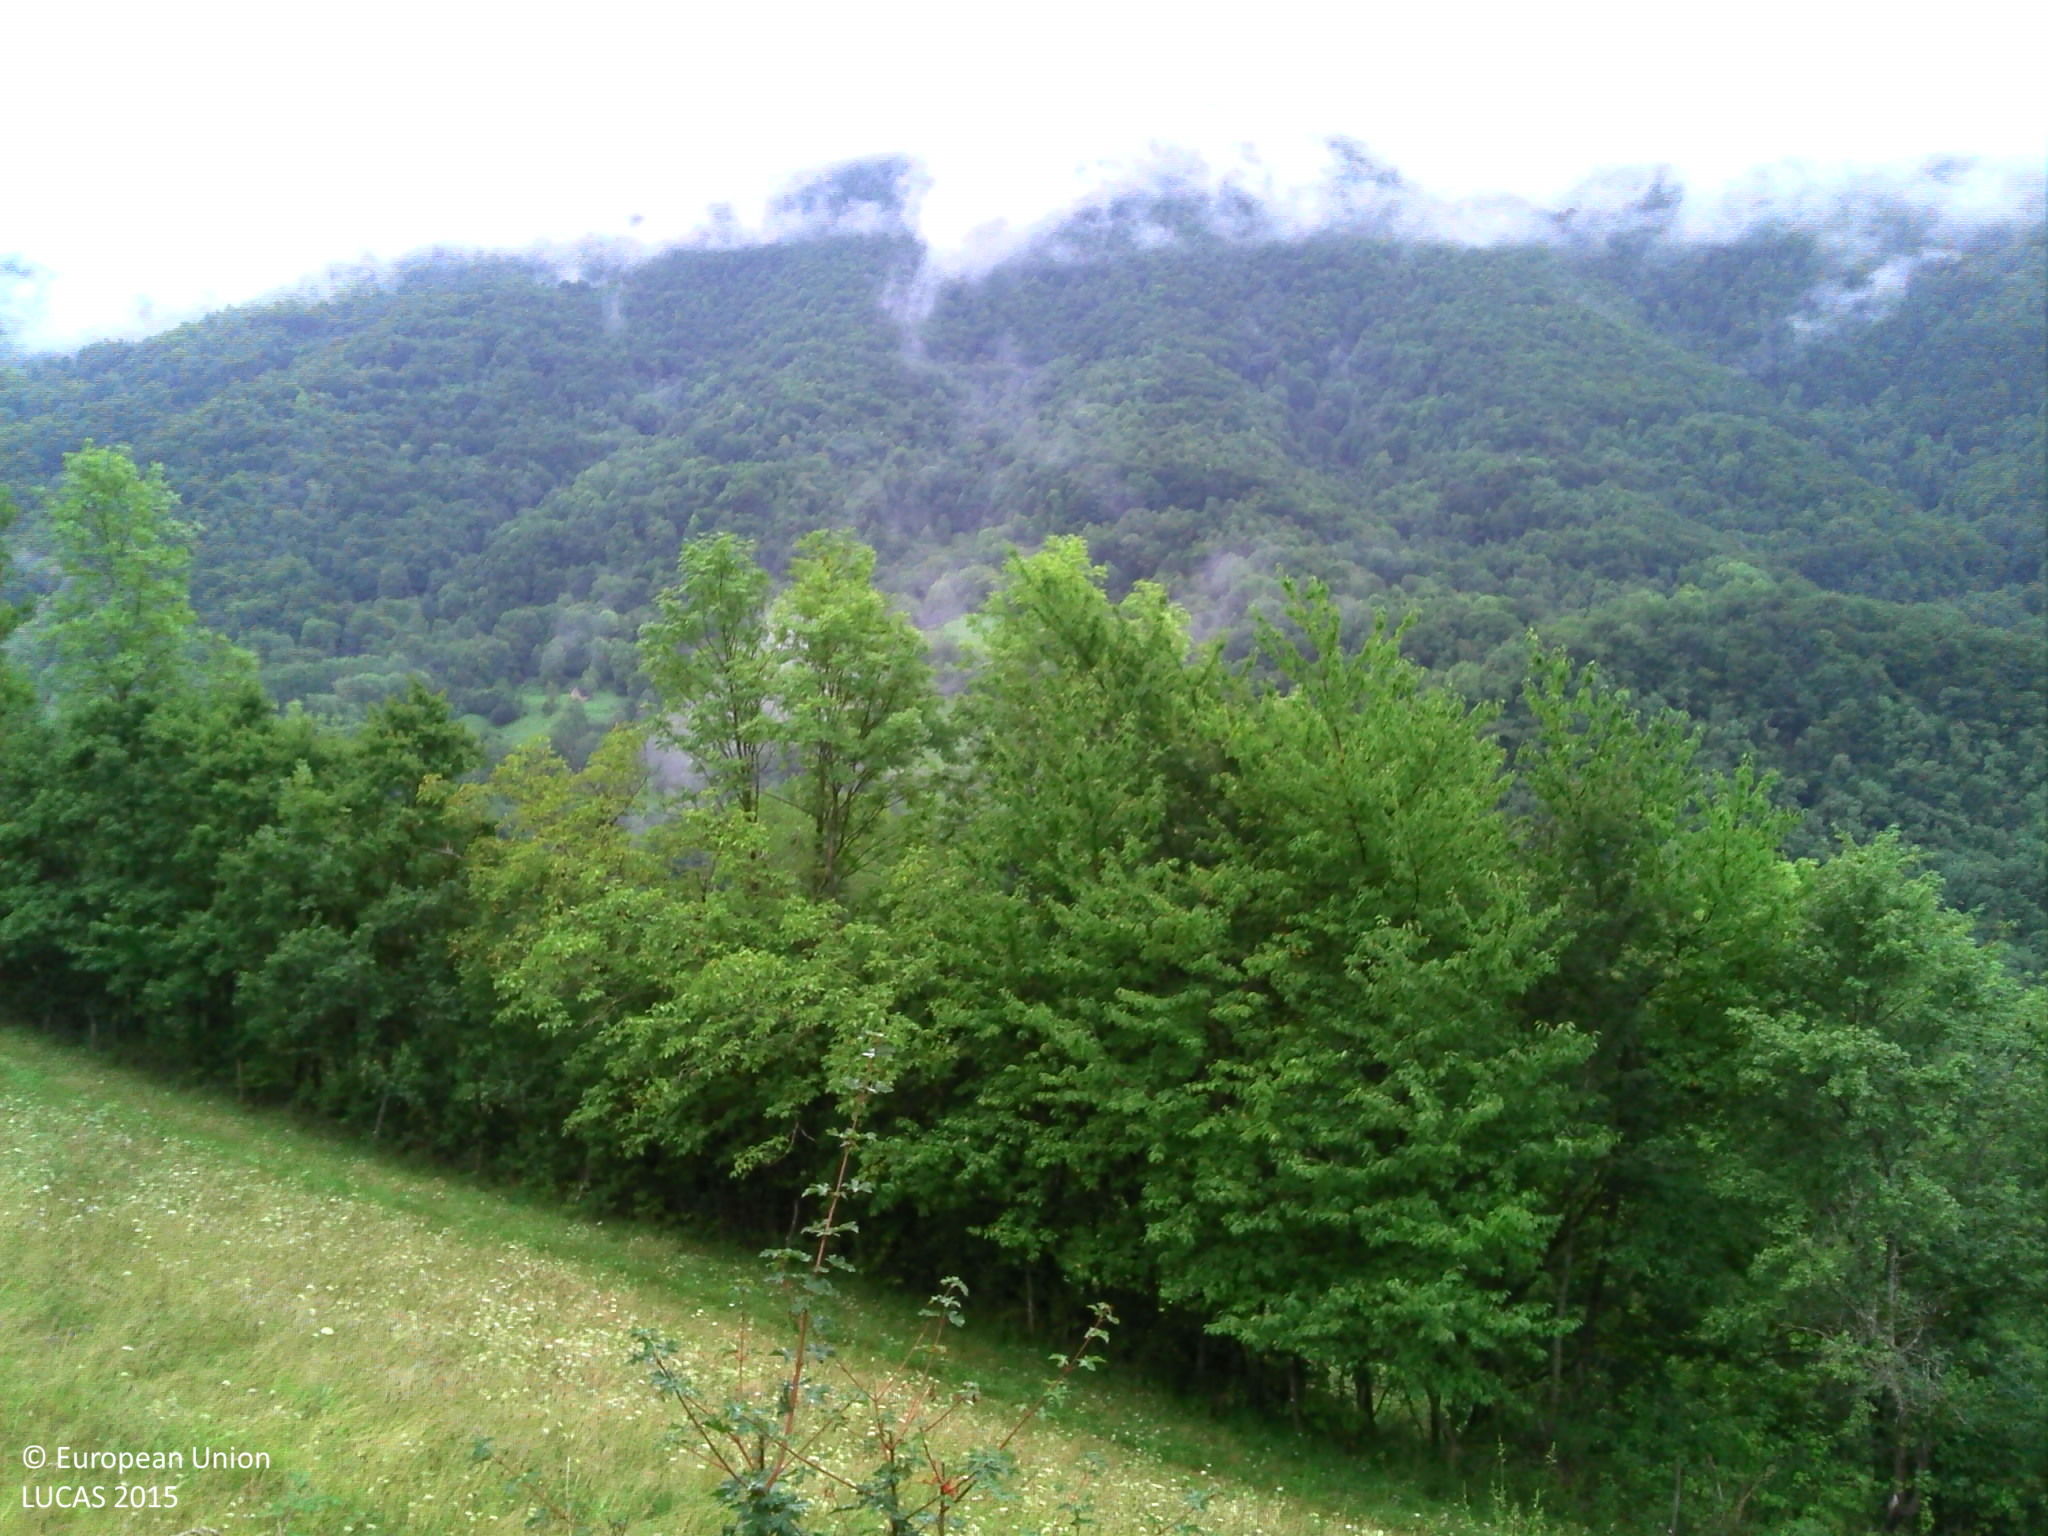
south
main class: Grassland
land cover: Spontaneously vegetated surfaces
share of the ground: > 75 %
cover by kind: herbaceous plants 100 %
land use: Semi-natural and natural areas not in use
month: August
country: FR
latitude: 42.8929
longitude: 1.0535
